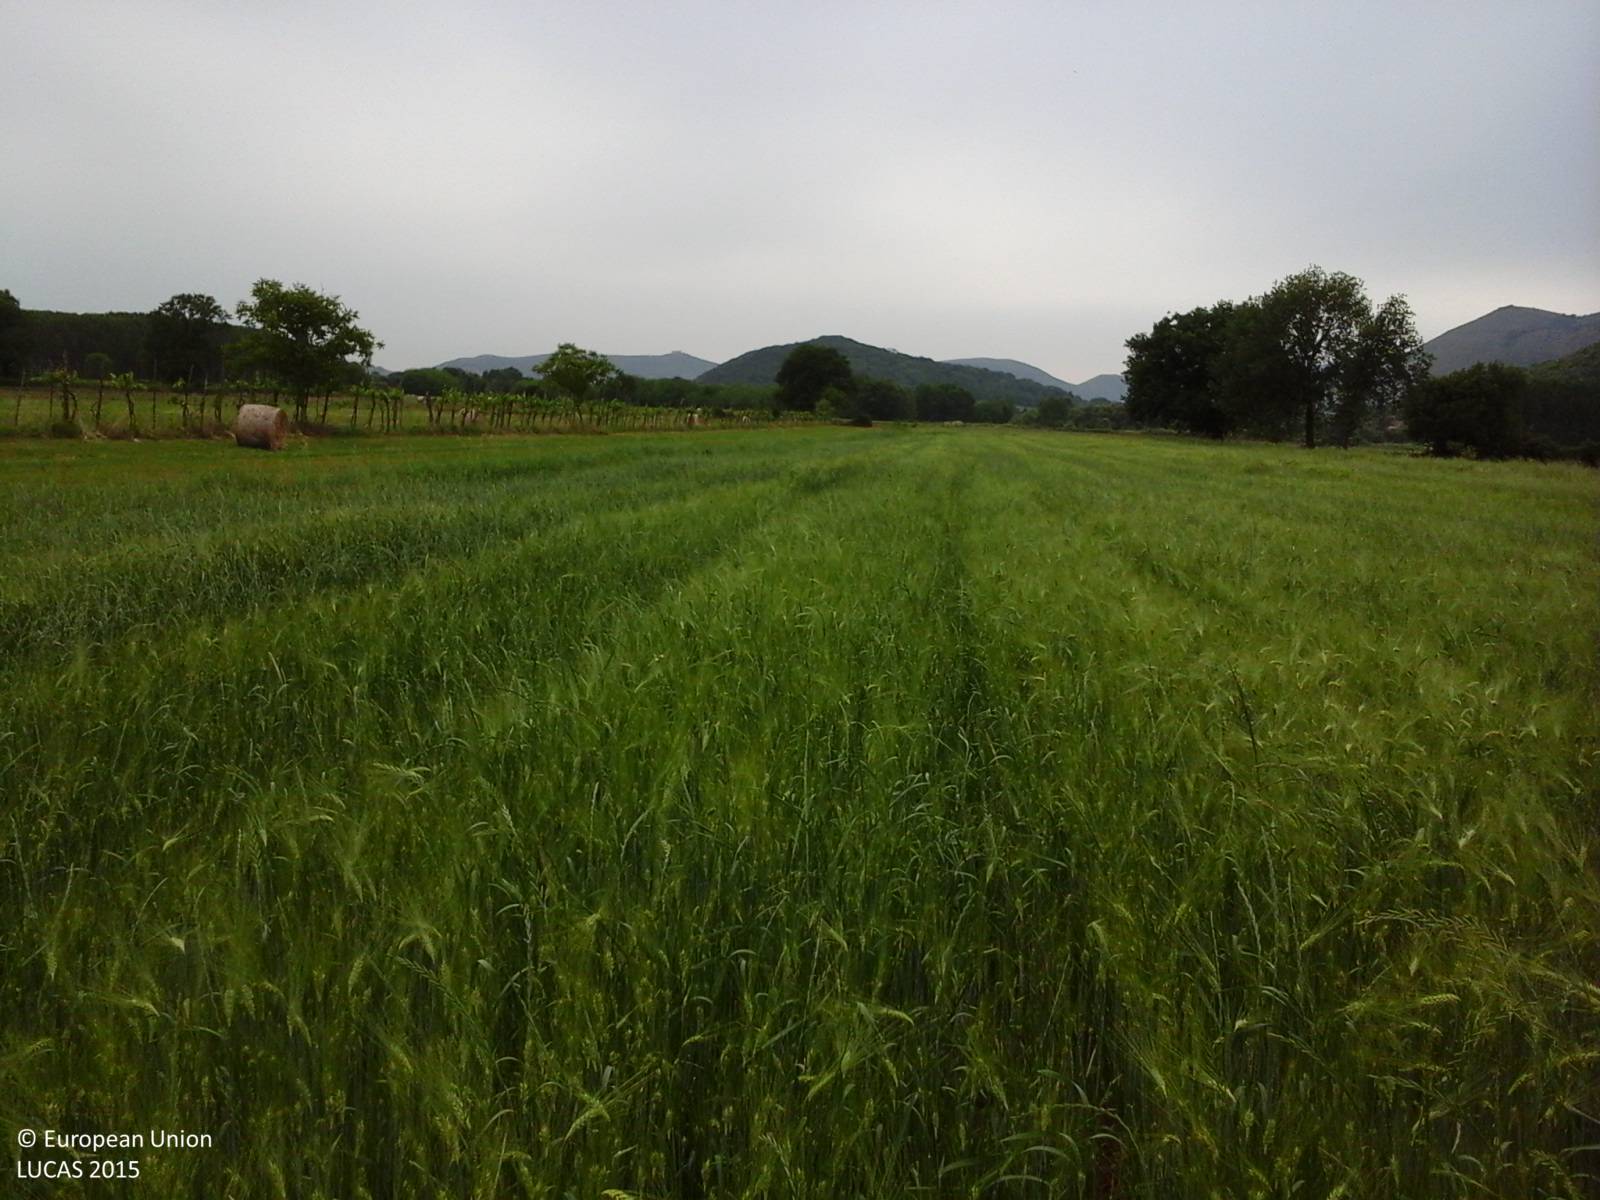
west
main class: Cropland
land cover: Barley
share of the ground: > 75 %
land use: Agriculture (excluding fallow land and kitchen gardens)
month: May
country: IT
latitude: 41.1489
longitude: 14.3559
